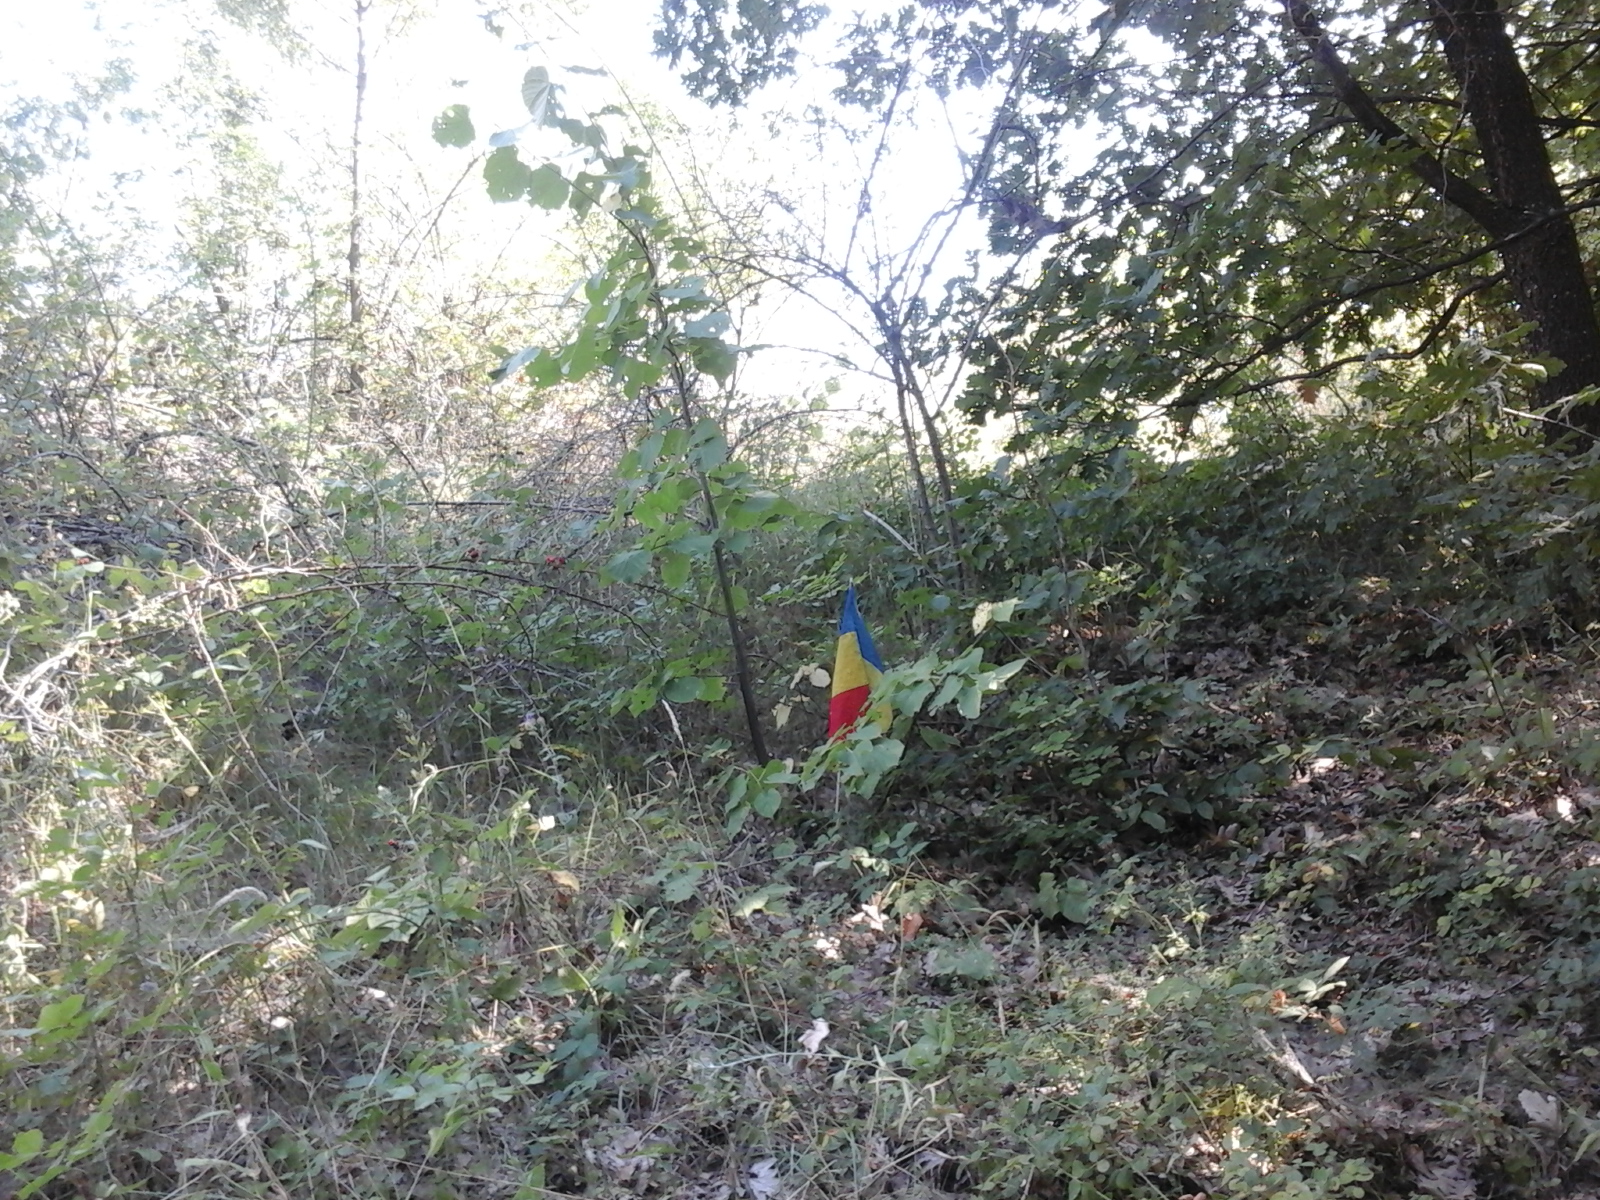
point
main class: Woodland
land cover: Broadleaved woodland
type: acidophilous oak and oak-birch forest
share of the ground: > 75 %
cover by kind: broadleaved forest trees 100 %
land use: Forestry
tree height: > 5 m
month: August
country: RO
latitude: 44.8899
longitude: 23.9025
